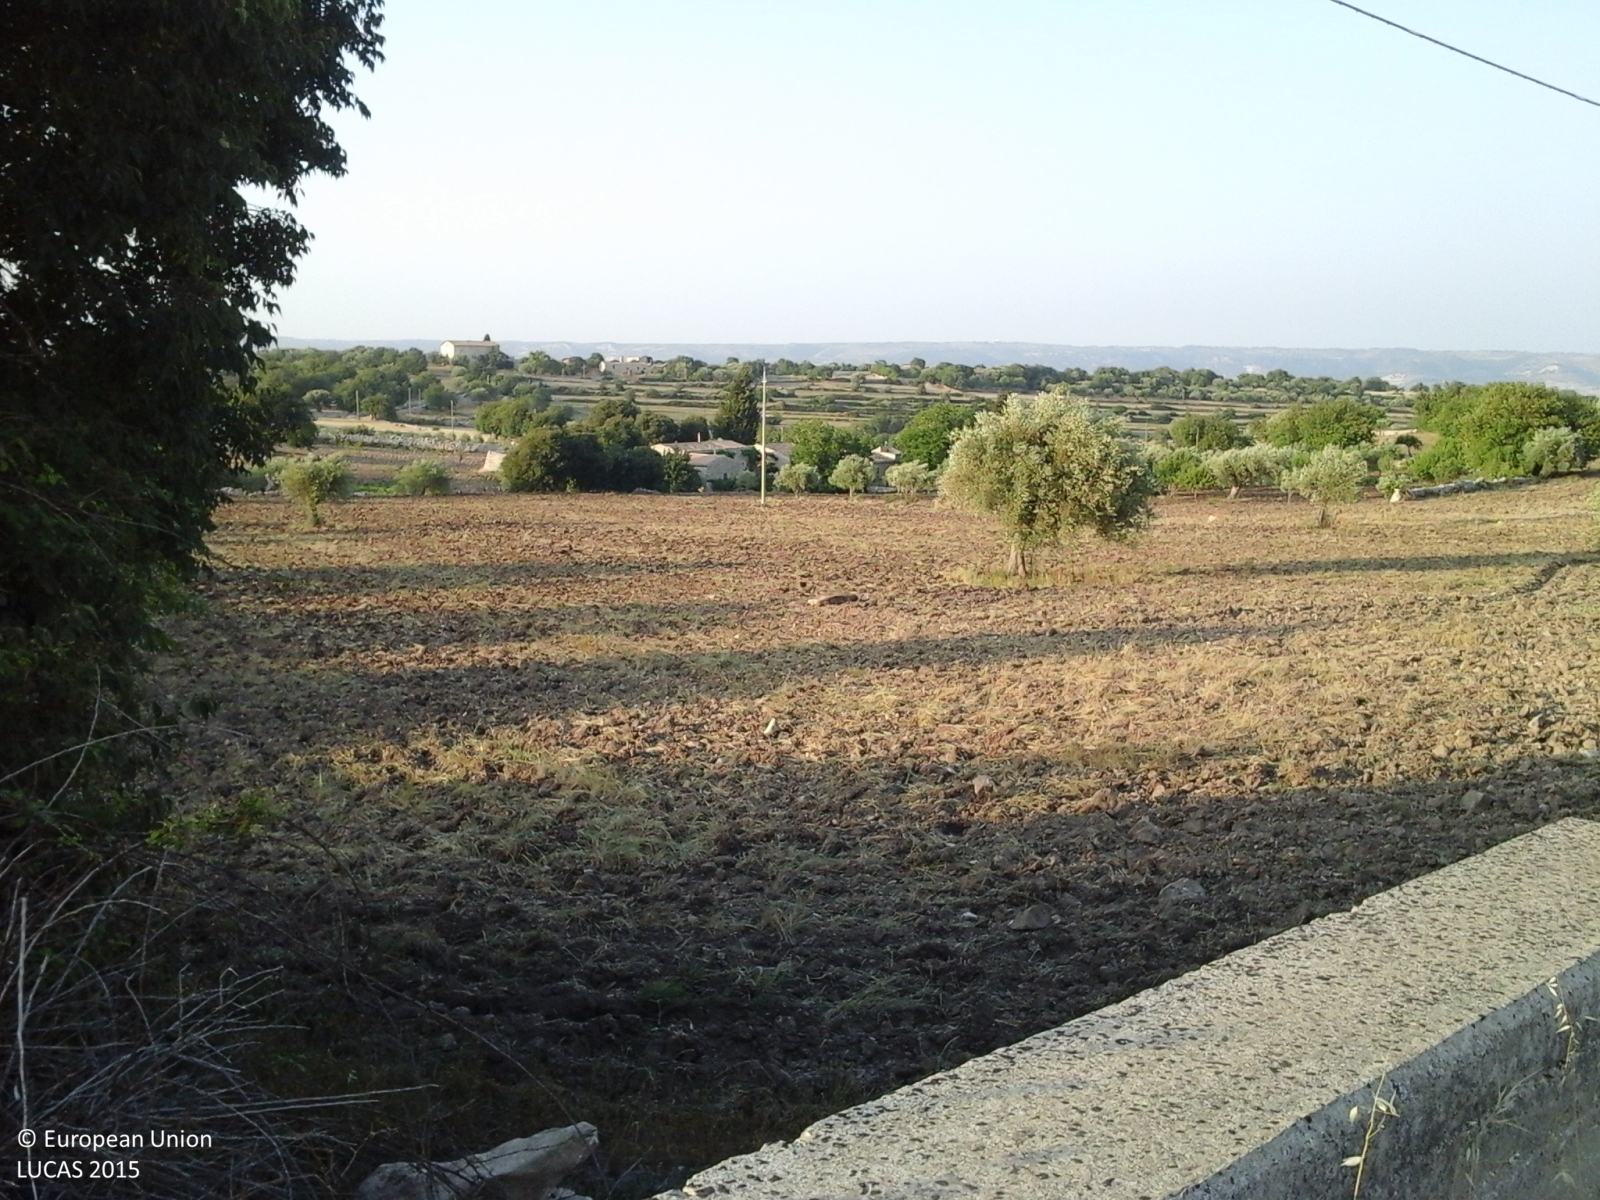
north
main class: Grassland
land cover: Grassland without tree/shrub cover
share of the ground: > 75 %
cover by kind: herbaceous plants 100 %
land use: Agriculture (excluding fallow land and kitchen gardens)
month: July
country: IT
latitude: 36.8954
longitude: 14.8653
